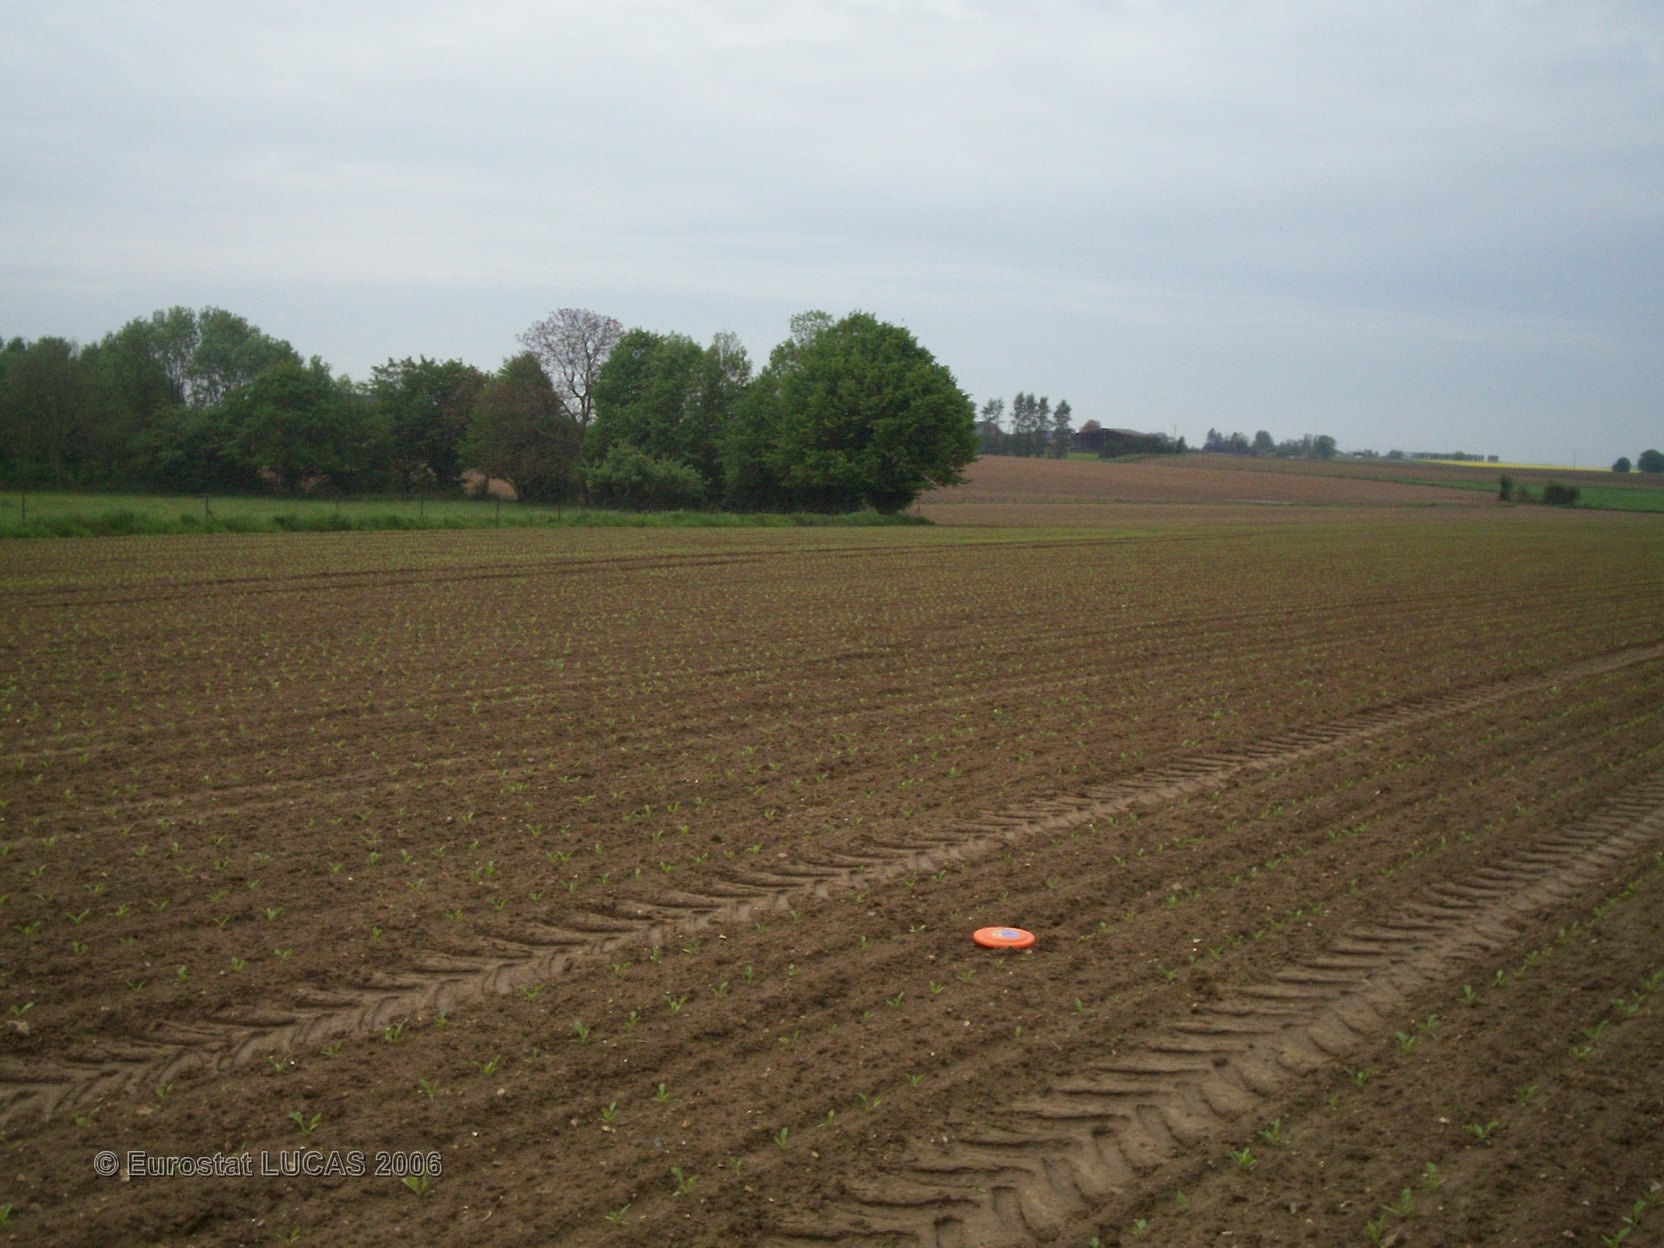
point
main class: Cropland
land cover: Sugar beet
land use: Agriculture (excluding fallow land and kitchen gardens)
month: May
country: FR
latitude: 49.9399
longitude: 3.7372
